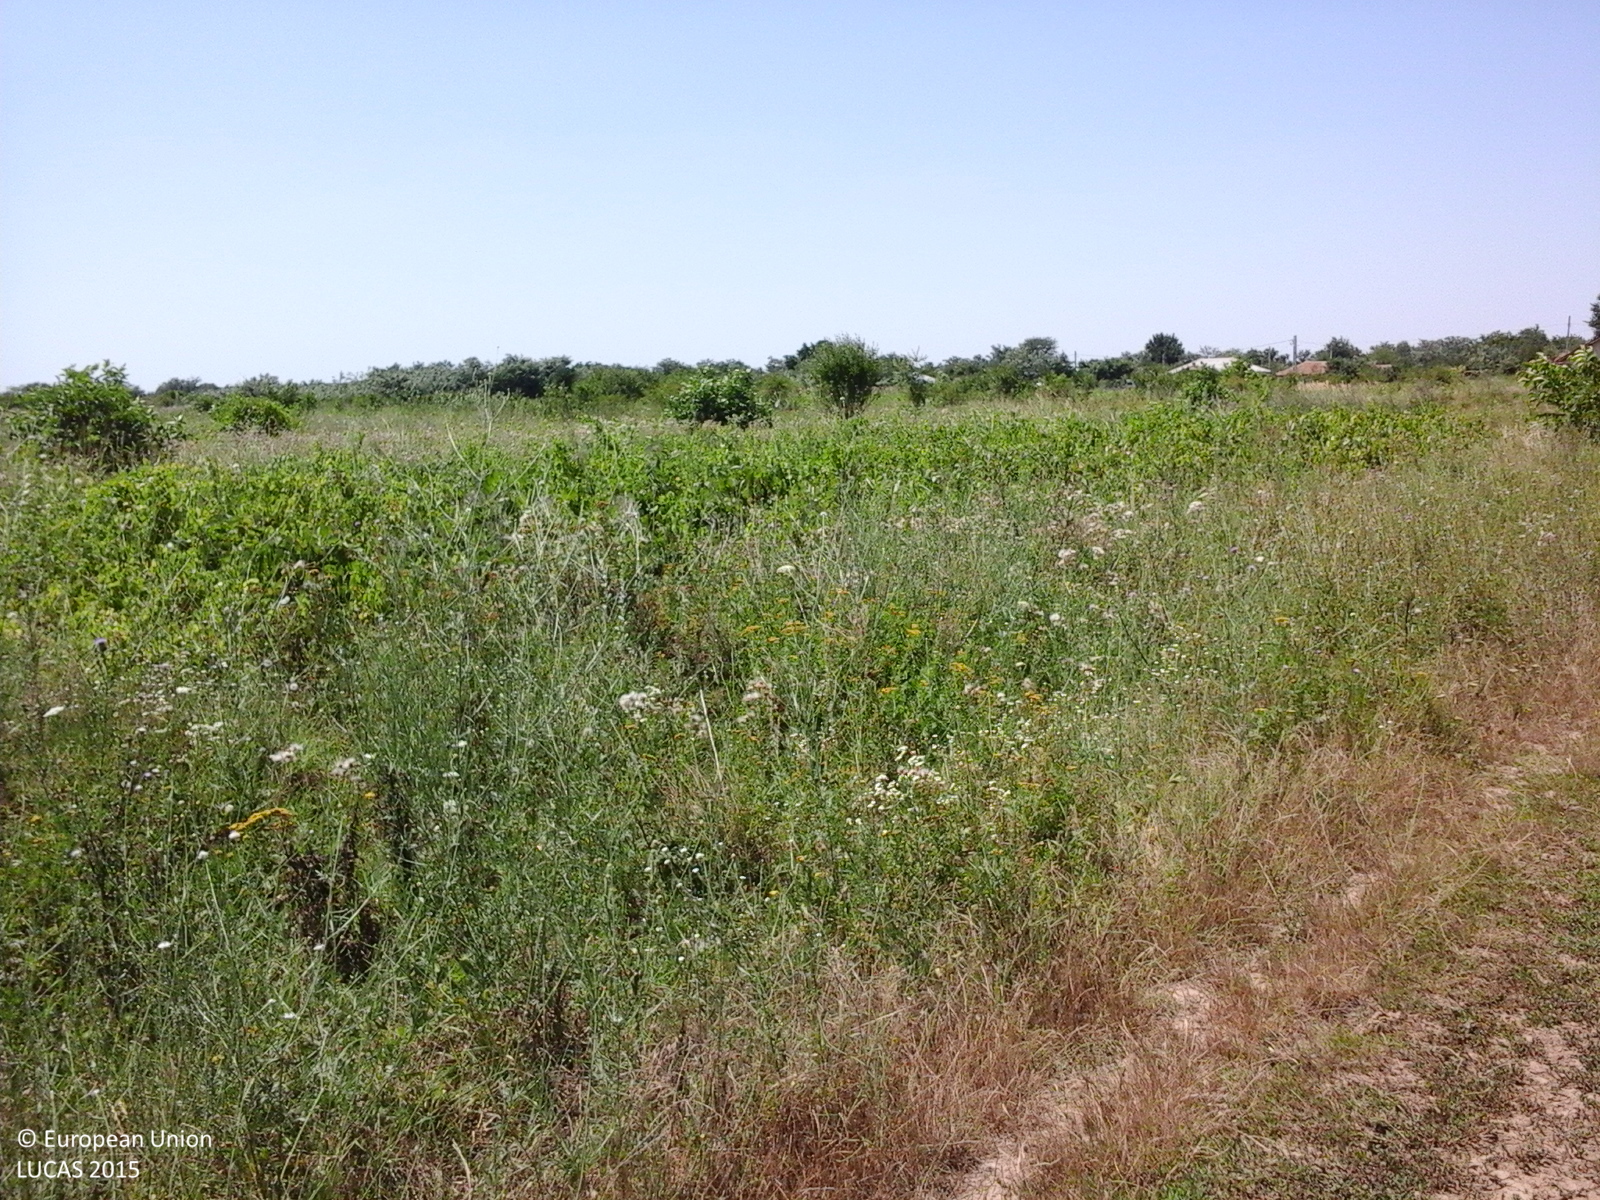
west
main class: Artificial land
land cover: Non built-up linear features
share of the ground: > 75 %
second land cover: Spontaneously vegetated surfaces
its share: 50 - 75 %
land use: Agriculture (excluding fallow land and kitchen gardens)
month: July
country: RO
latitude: 44.3174
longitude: 26.4236
